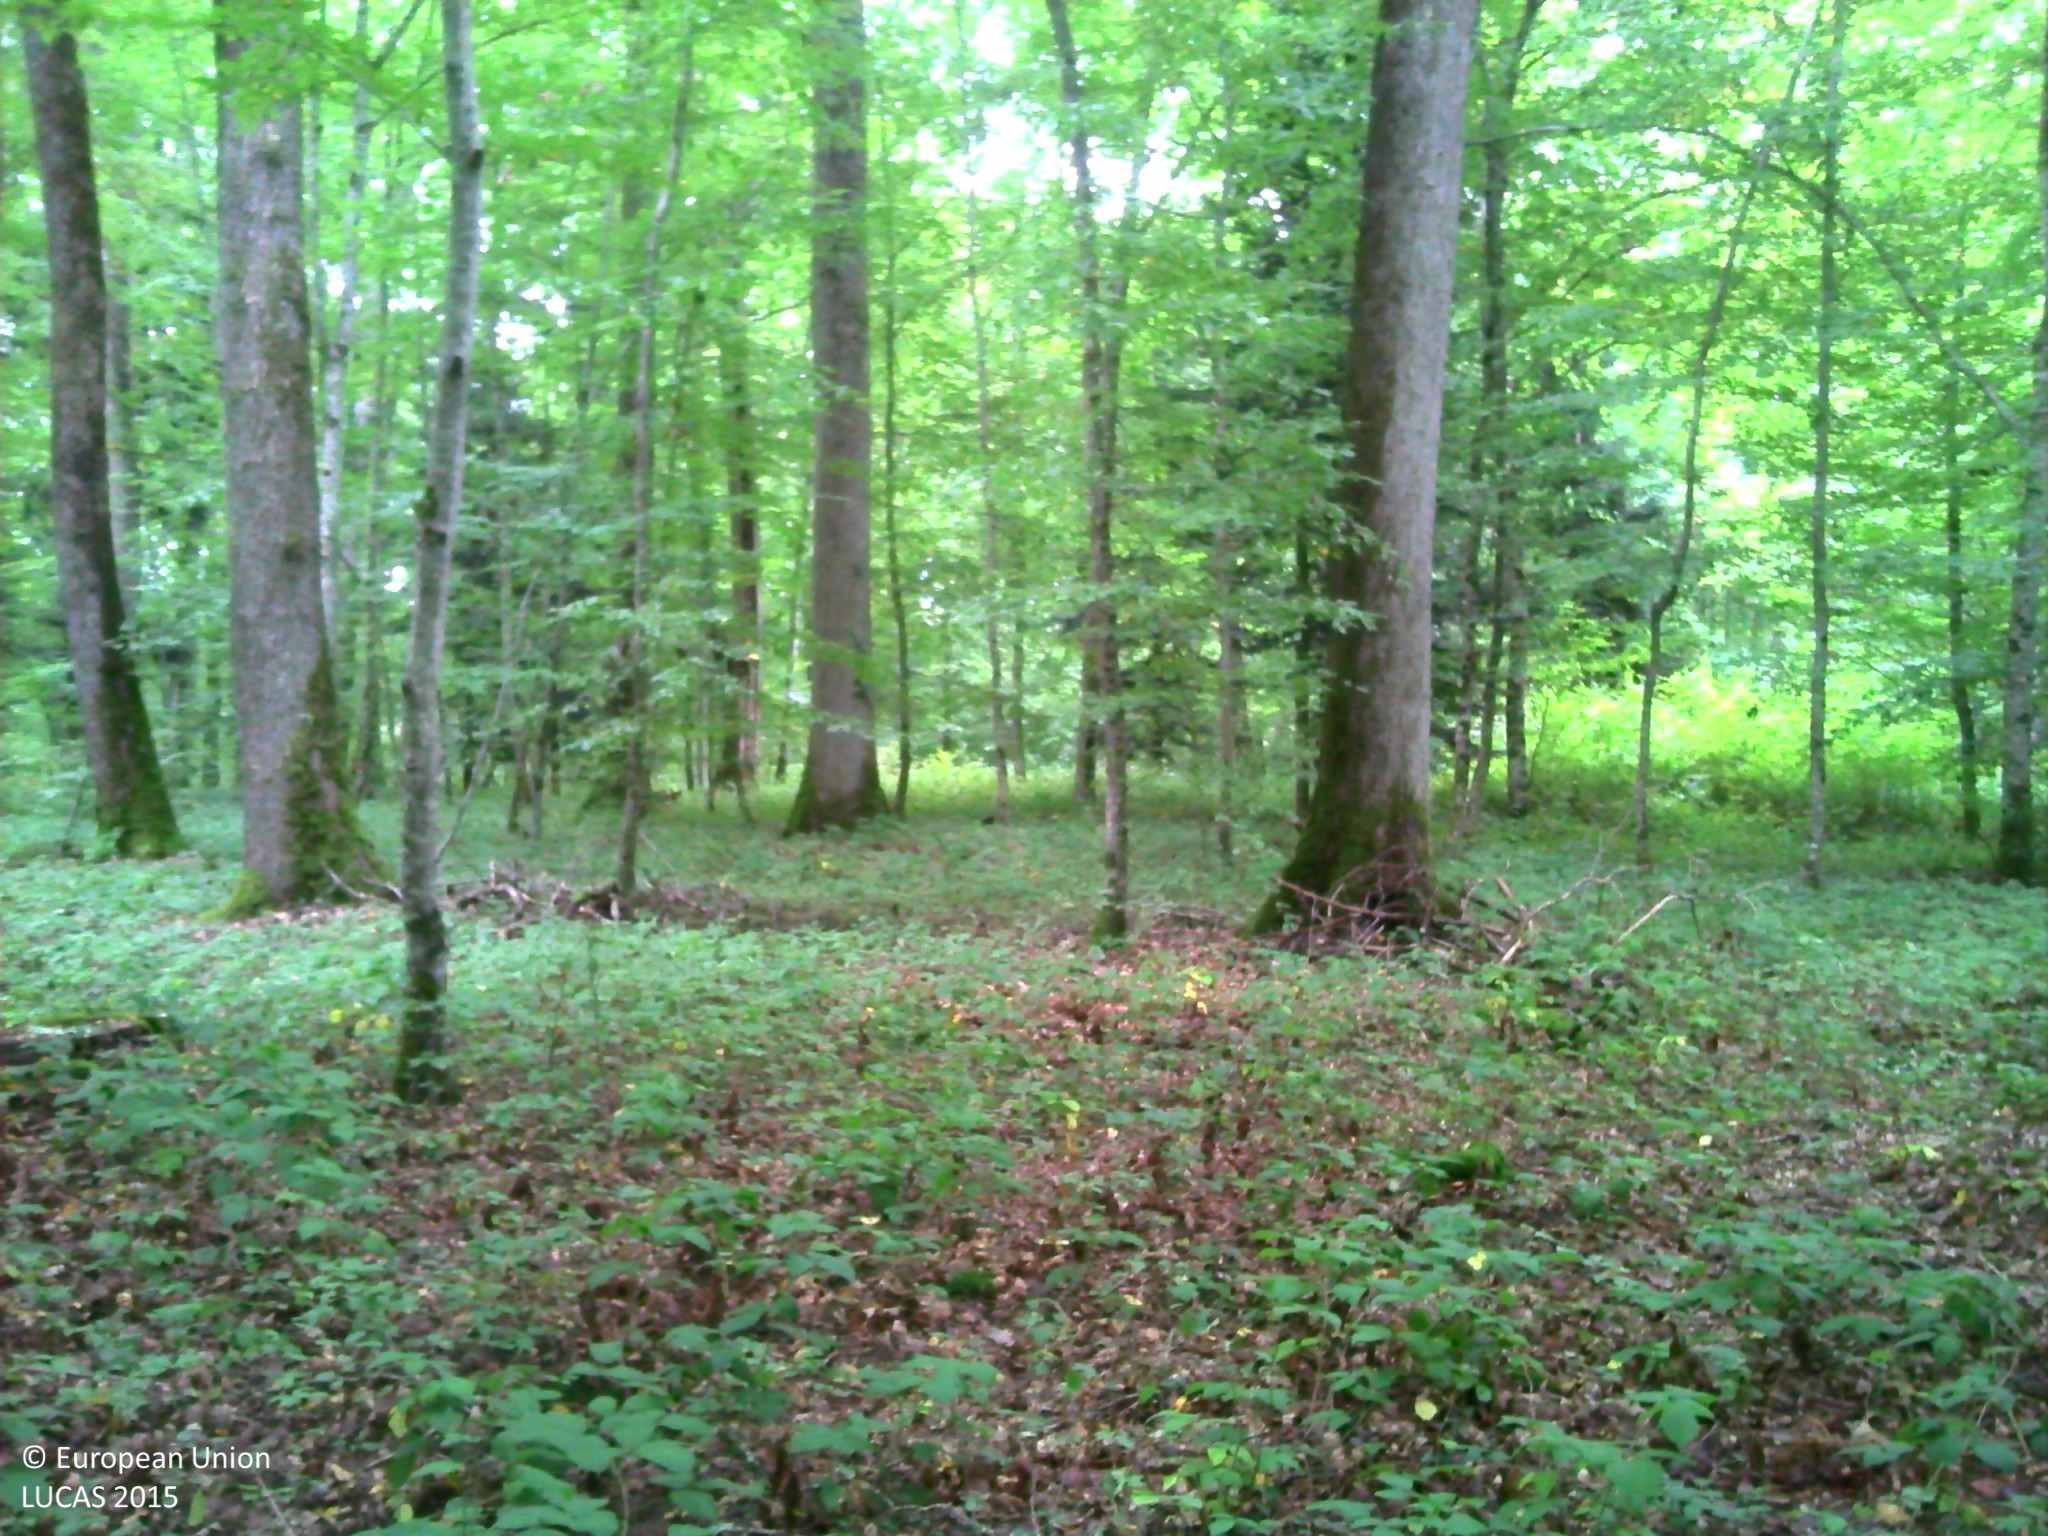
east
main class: Woodland
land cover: Broadleaved woodland
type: mesophytic deciduous forest
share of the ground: > 75 %
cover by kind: broadleaved forest trees 100 %
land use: Forestry
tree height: > 5 m
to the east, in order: Broadleaved woodland; Ditches and canals; Grass margins; Tracks; Grass margins; Ditches and canals; Broadleaved woodland
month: September
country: FR
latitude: 47.1621
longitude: 4.4198
